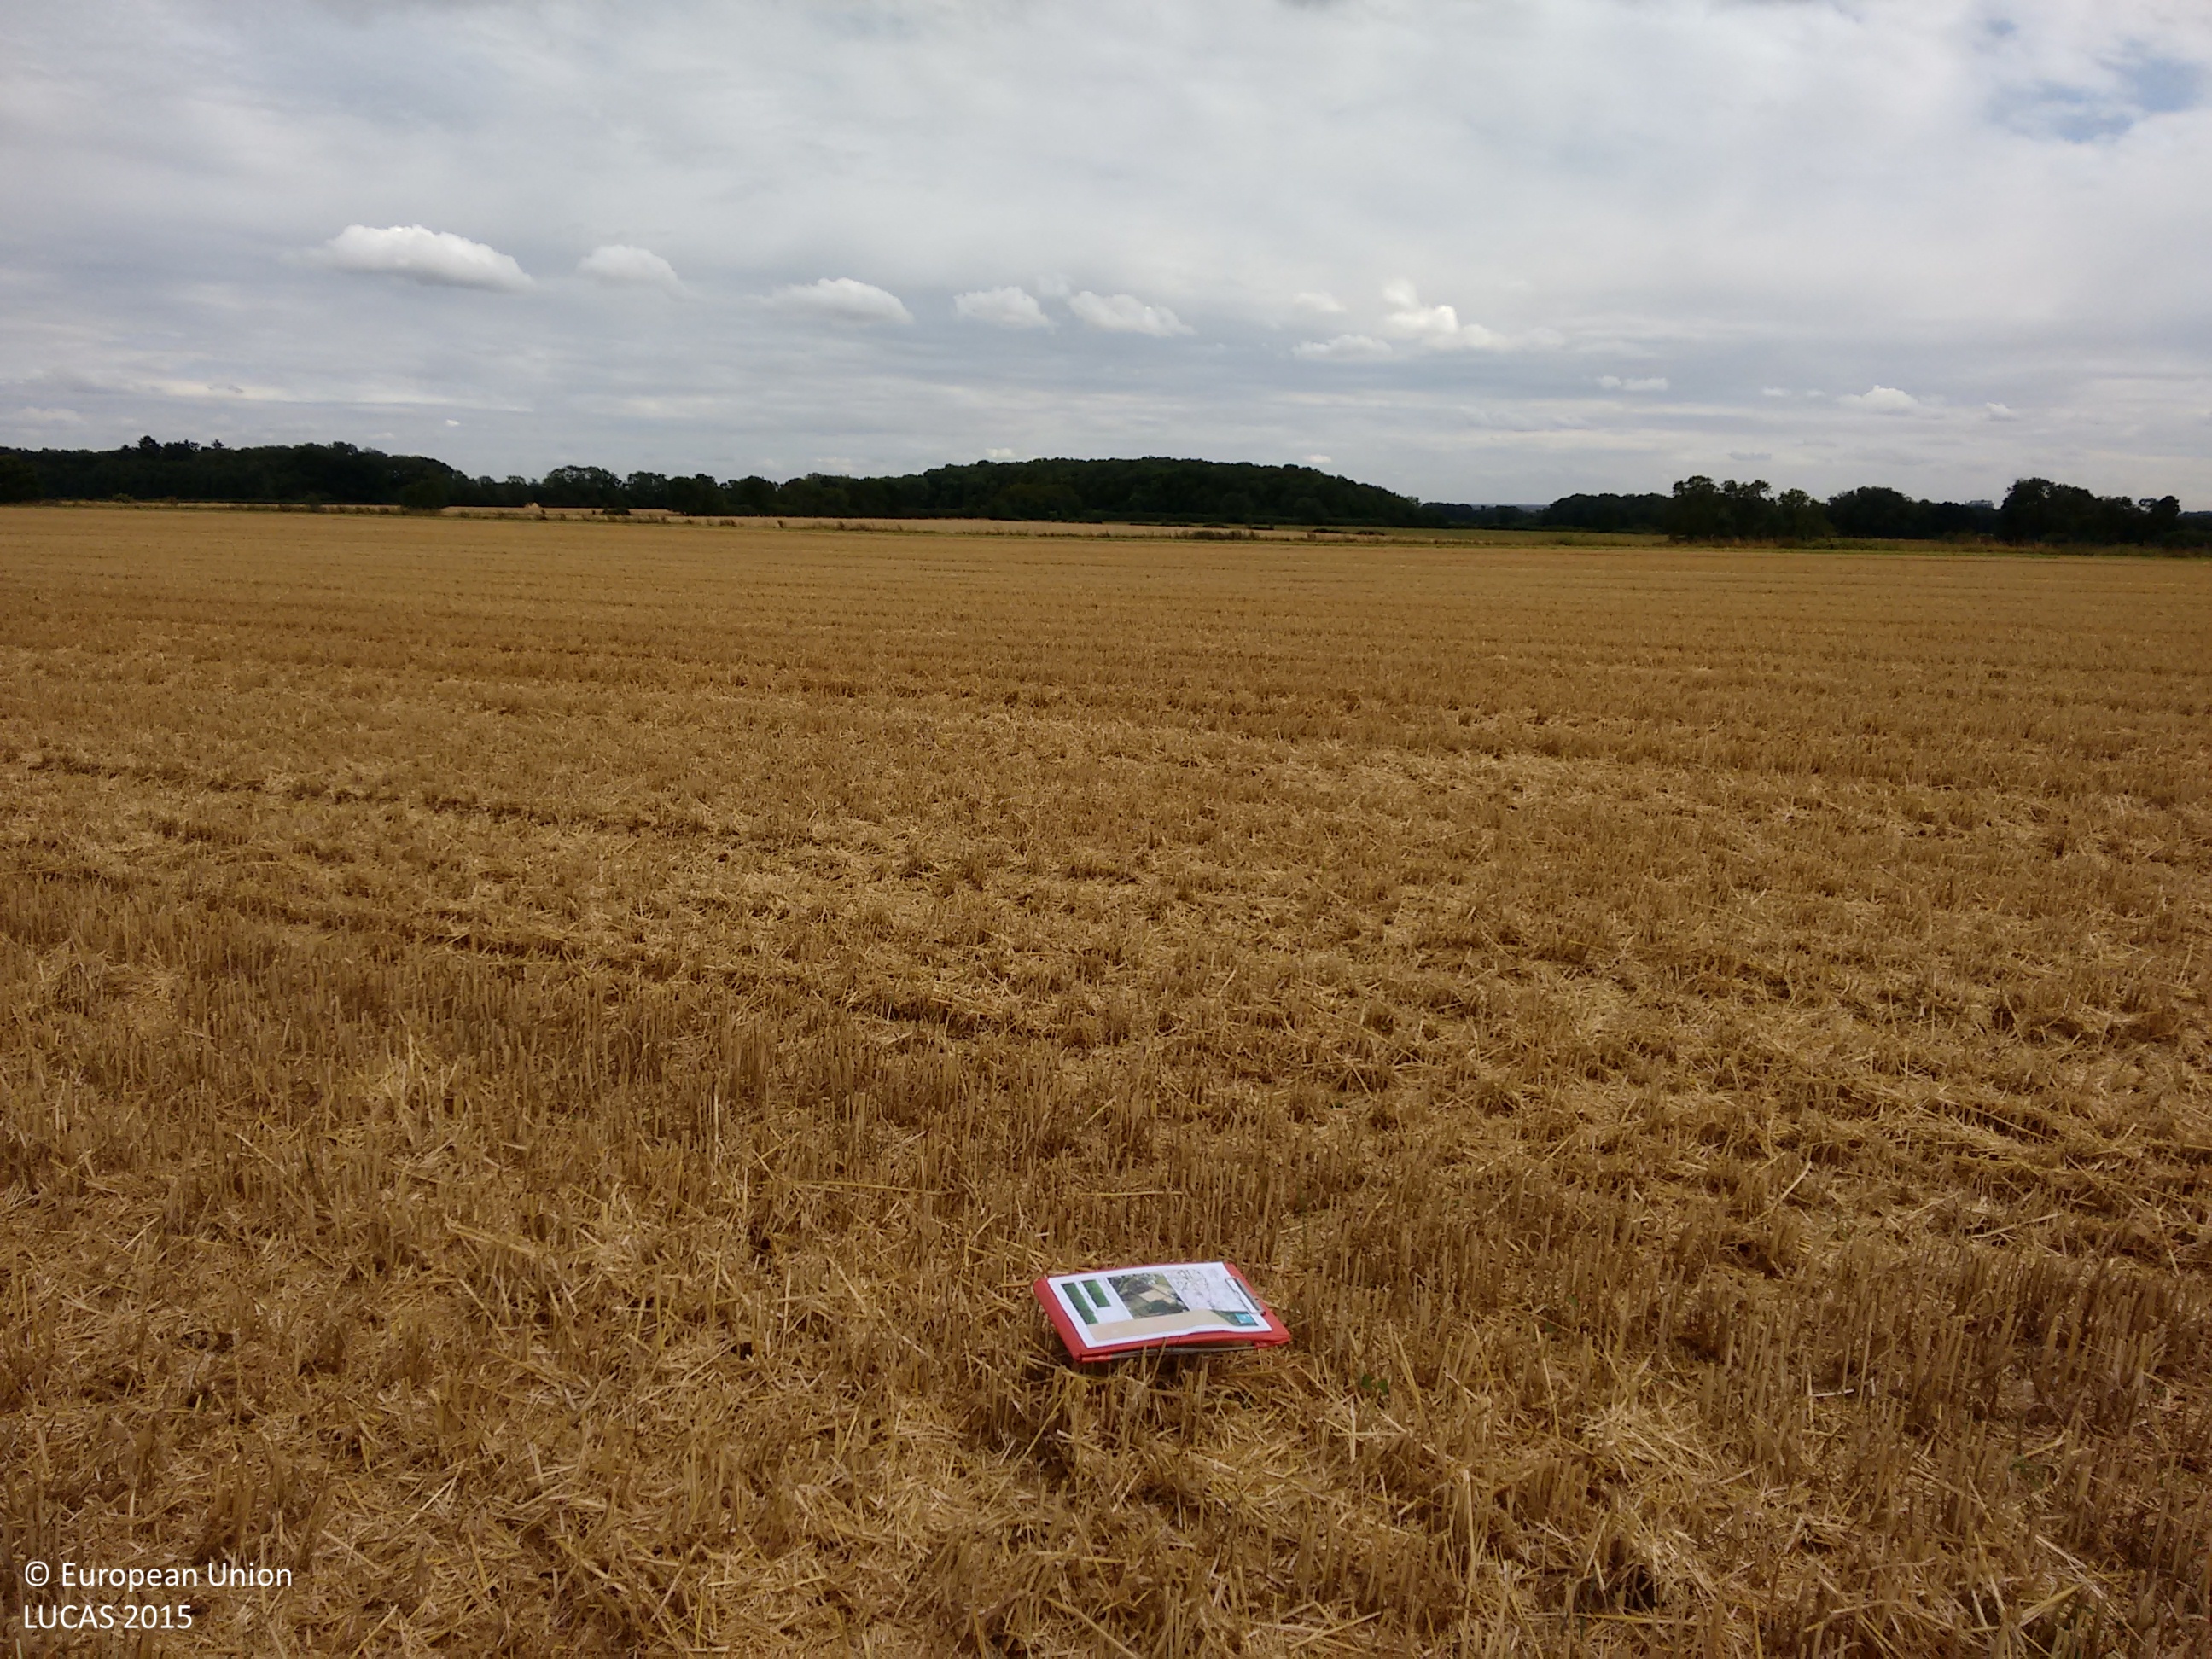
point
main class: Cropland
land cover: Common wheat
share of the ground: > 75 %
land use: Agriculture (excluding fallow land and kitchen gardens)
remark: Harvested field
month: August
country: GB
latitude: 52.6047
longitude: 0.4182
